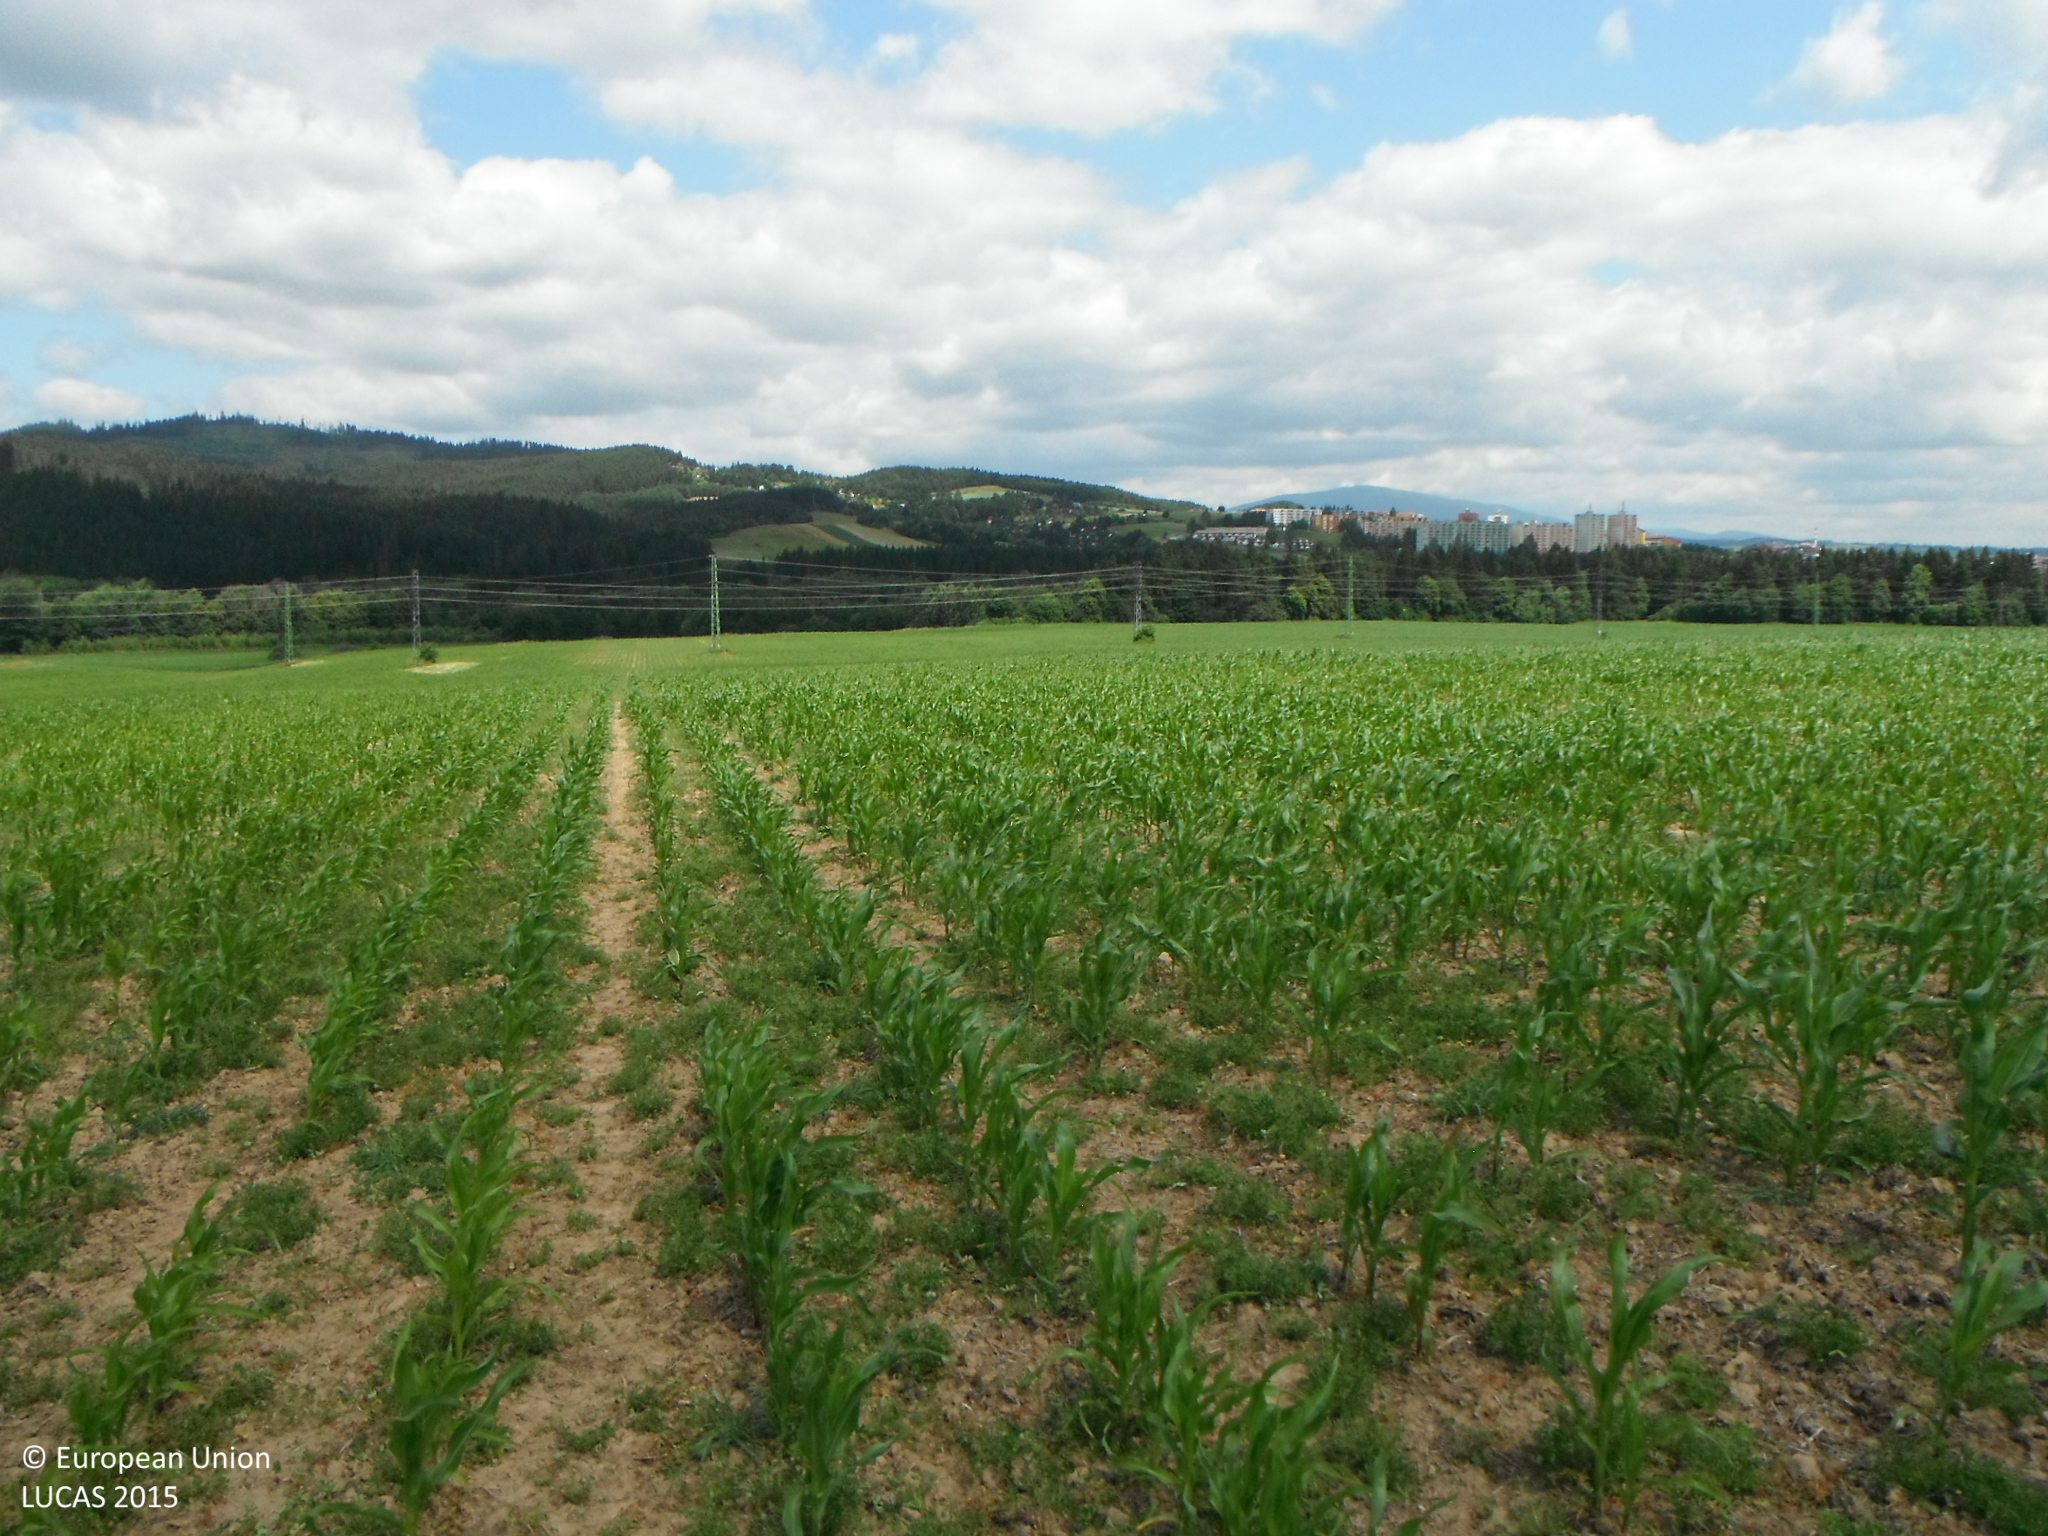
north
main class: Cropland
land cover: Maize
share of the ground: 25 - 50 %
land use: Agriculture (excluding fallow land and kitchen gardens)
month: July
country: SK
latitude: 49.3914
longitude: 19.4637
